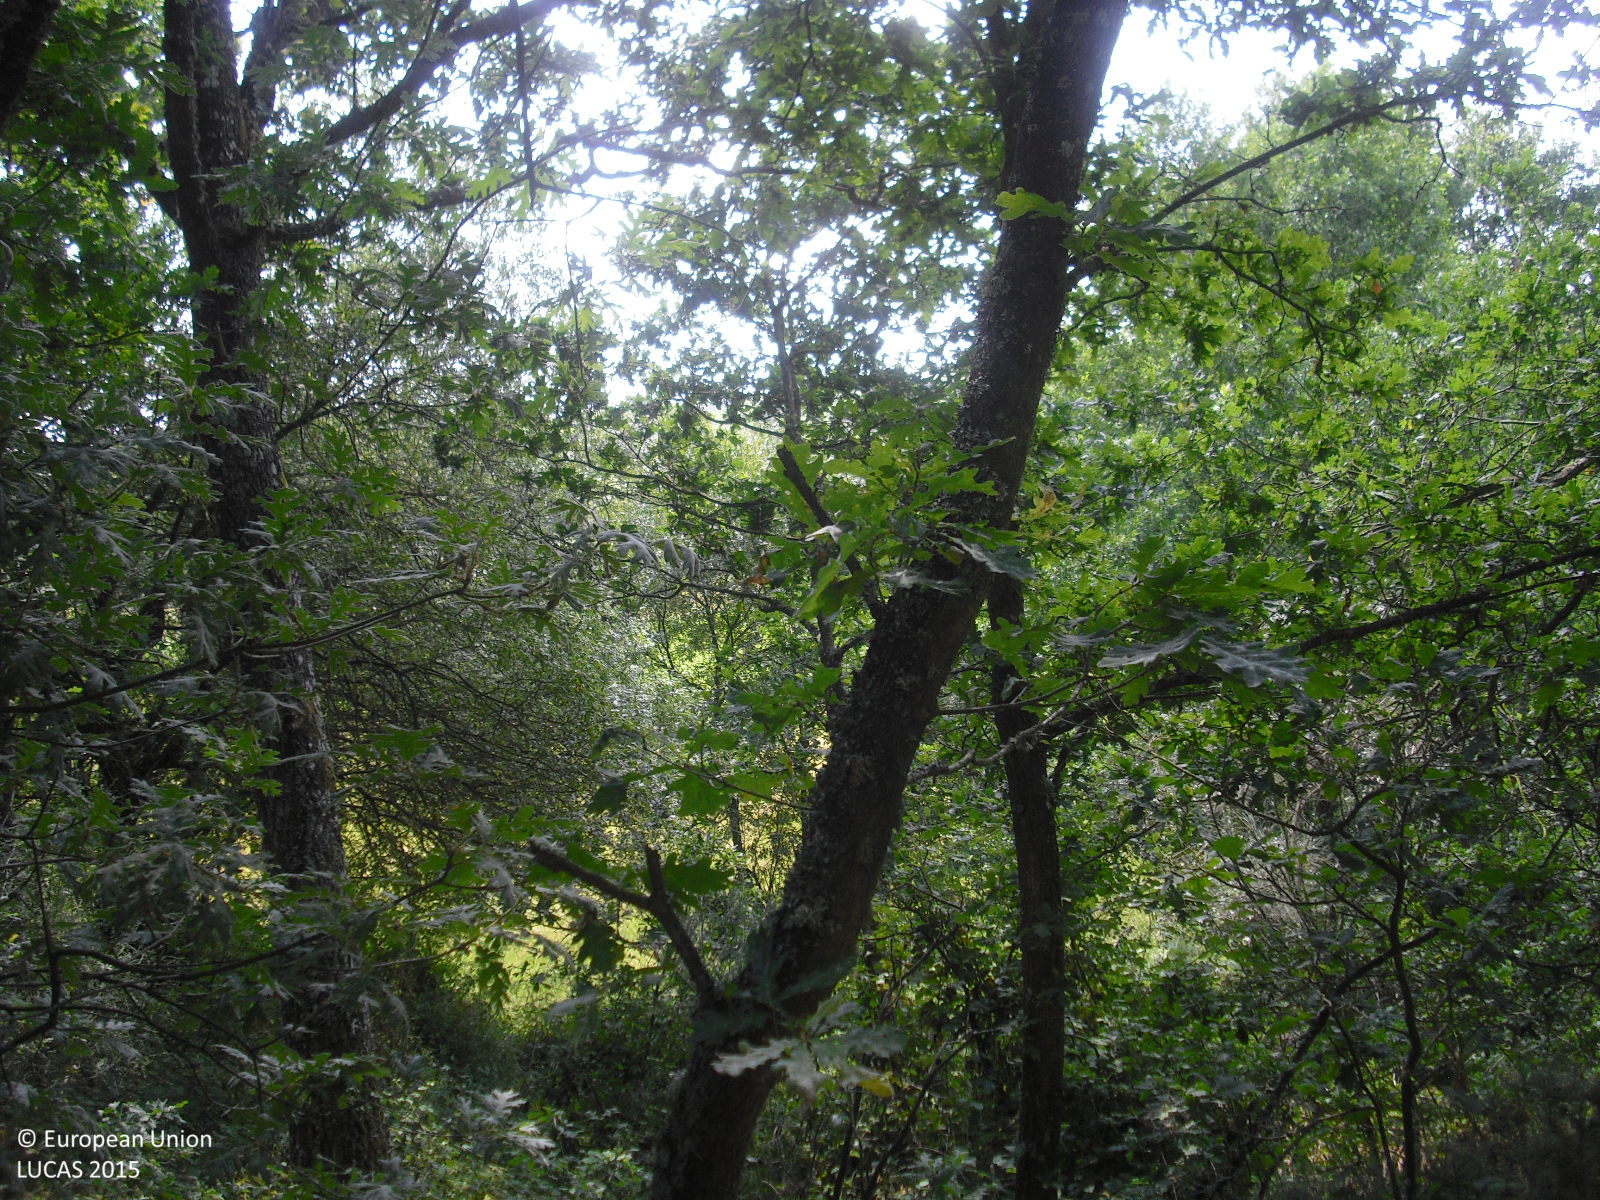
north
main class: Woodland
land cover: Broadleaved woodland
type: acidophilous oak and oak-birch forest
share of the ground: > 75 %
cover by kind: broadleaved forest trees 100 %
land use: Semi-natural and natural areas not in use
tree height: > 5 m
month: June
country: ES
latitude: 42.6441
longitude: -7.8261
